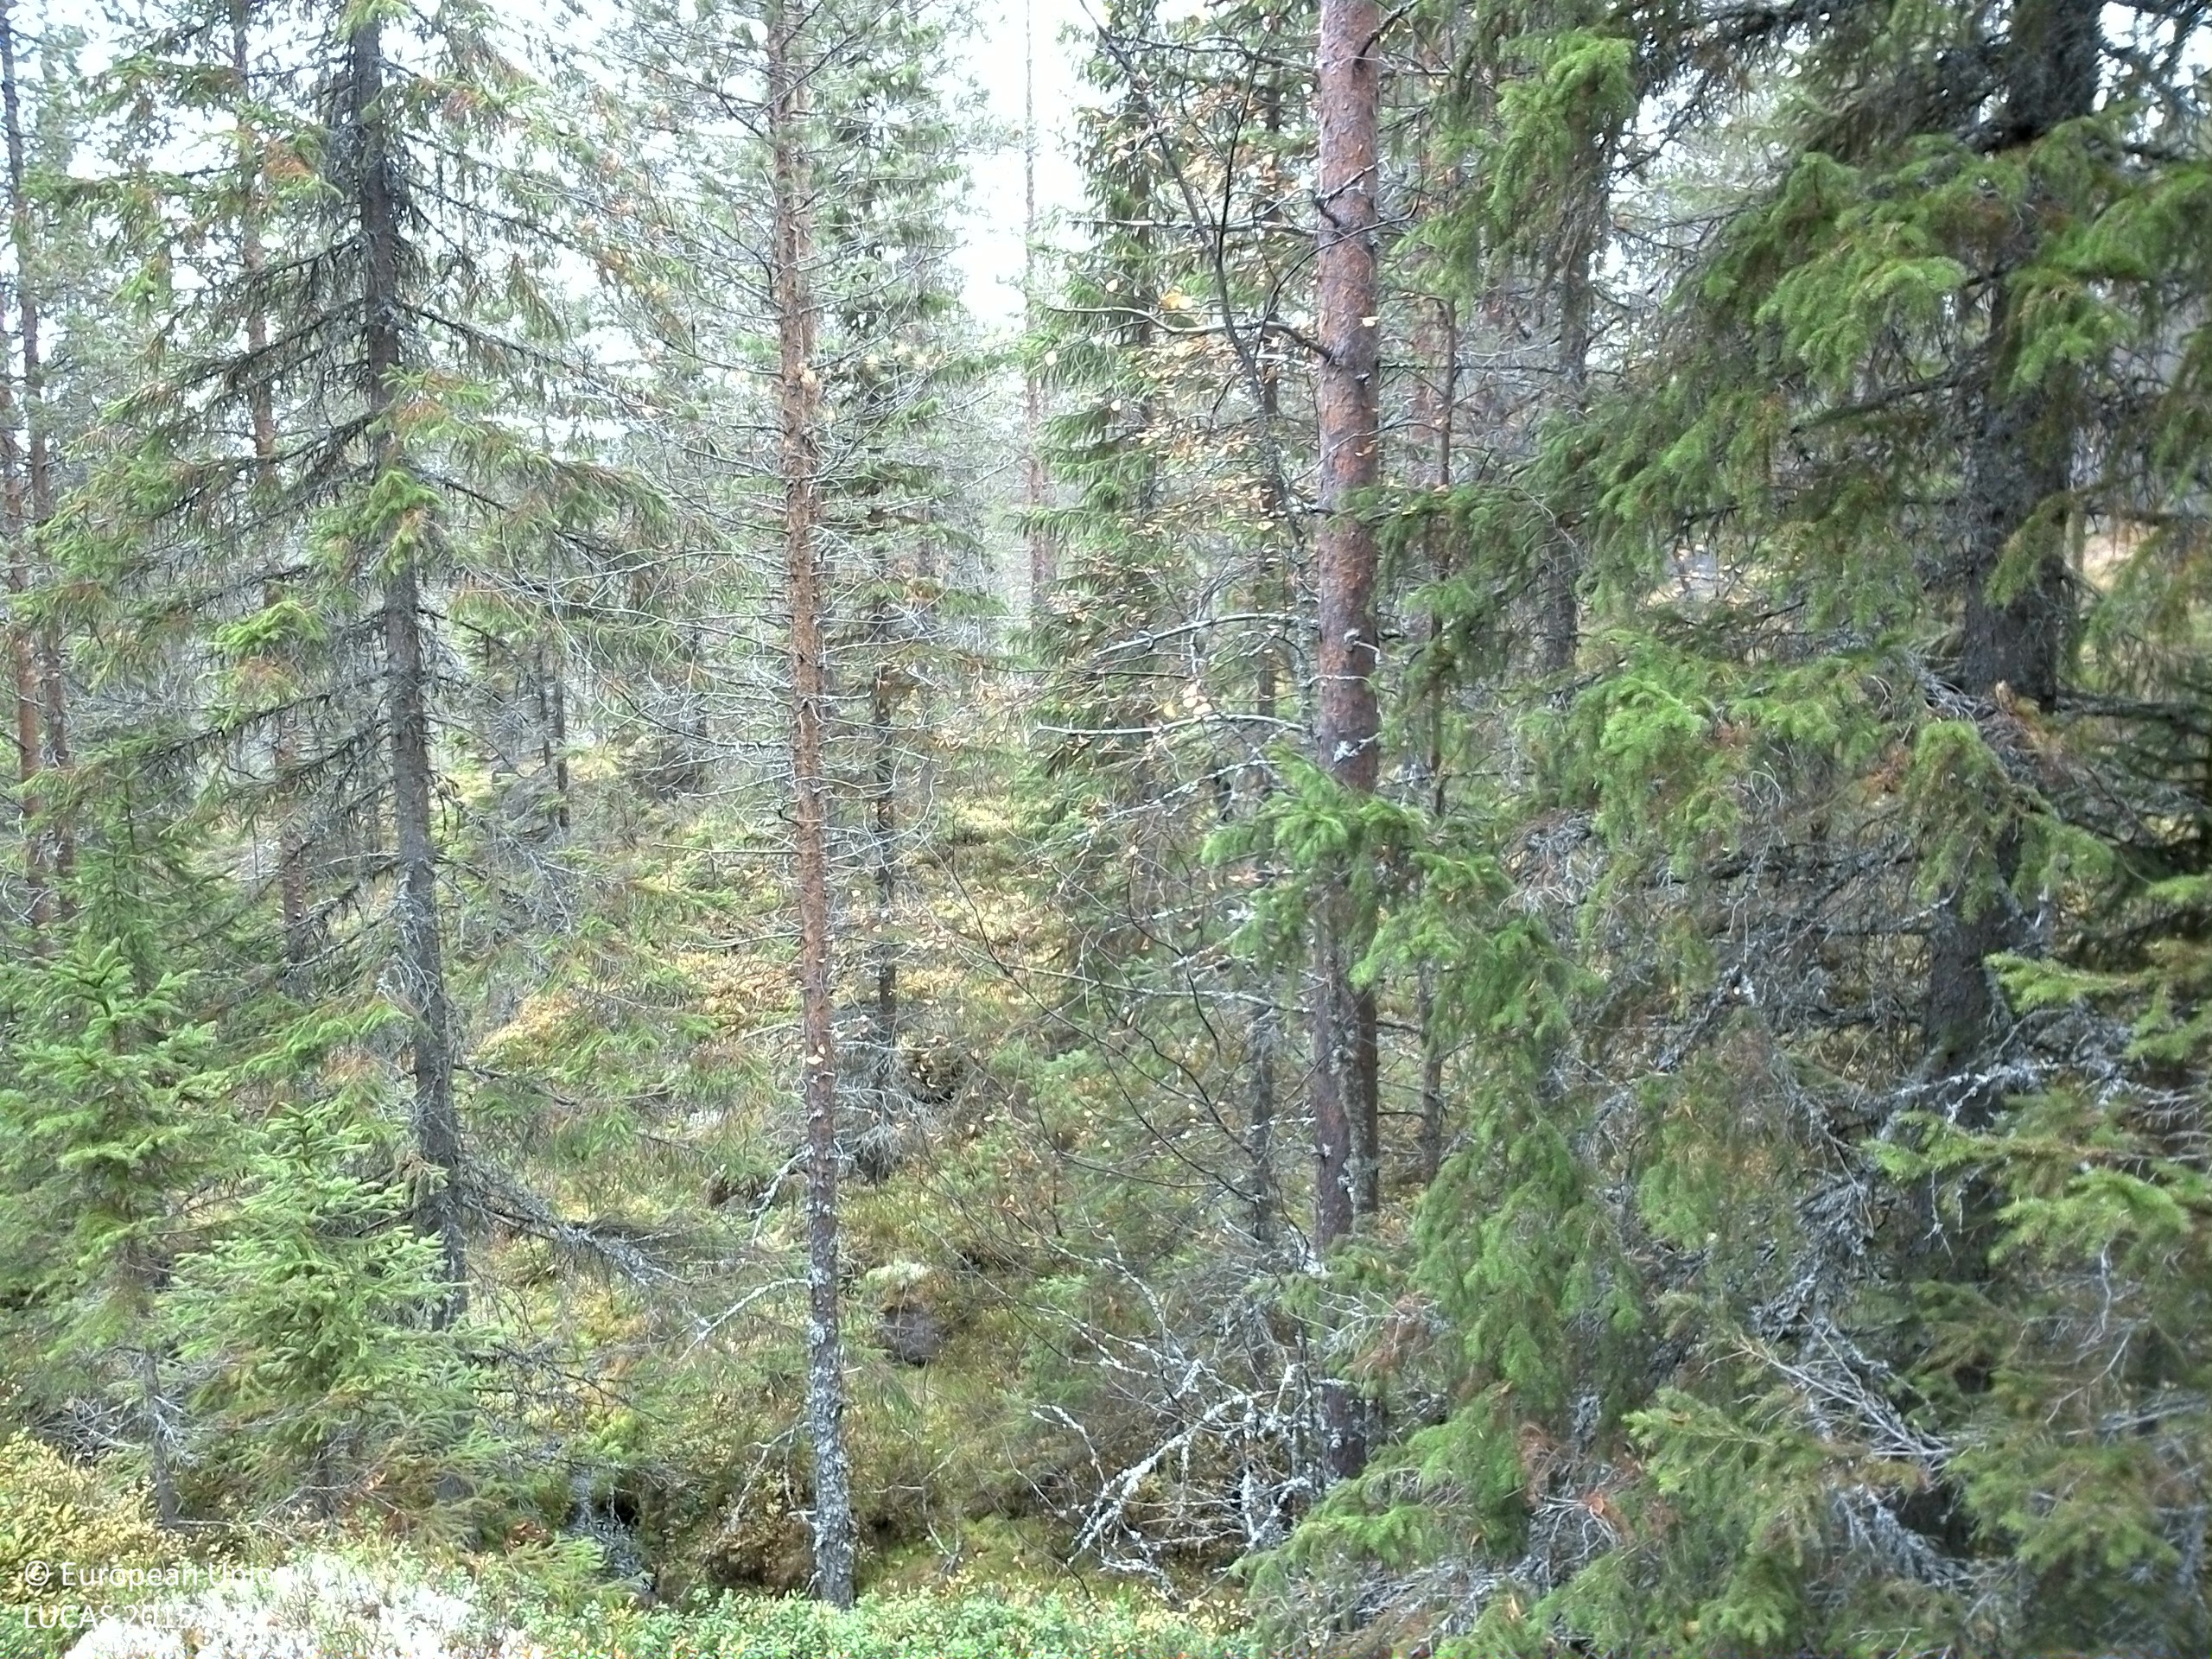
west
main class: Woodland
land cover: Spruce dominated coniferous woodland
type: boreal forest
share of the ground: 25 - 50 %
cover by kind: coniferous forest trees 45 %, shrubs 30 %, lichens and mosses 15 %, consolidated bare surface 10 %
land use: Forestry
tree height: > 5 m
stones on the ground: 10 - 25 %
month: October
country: SE
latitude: 61.5370
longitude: 14.4053
